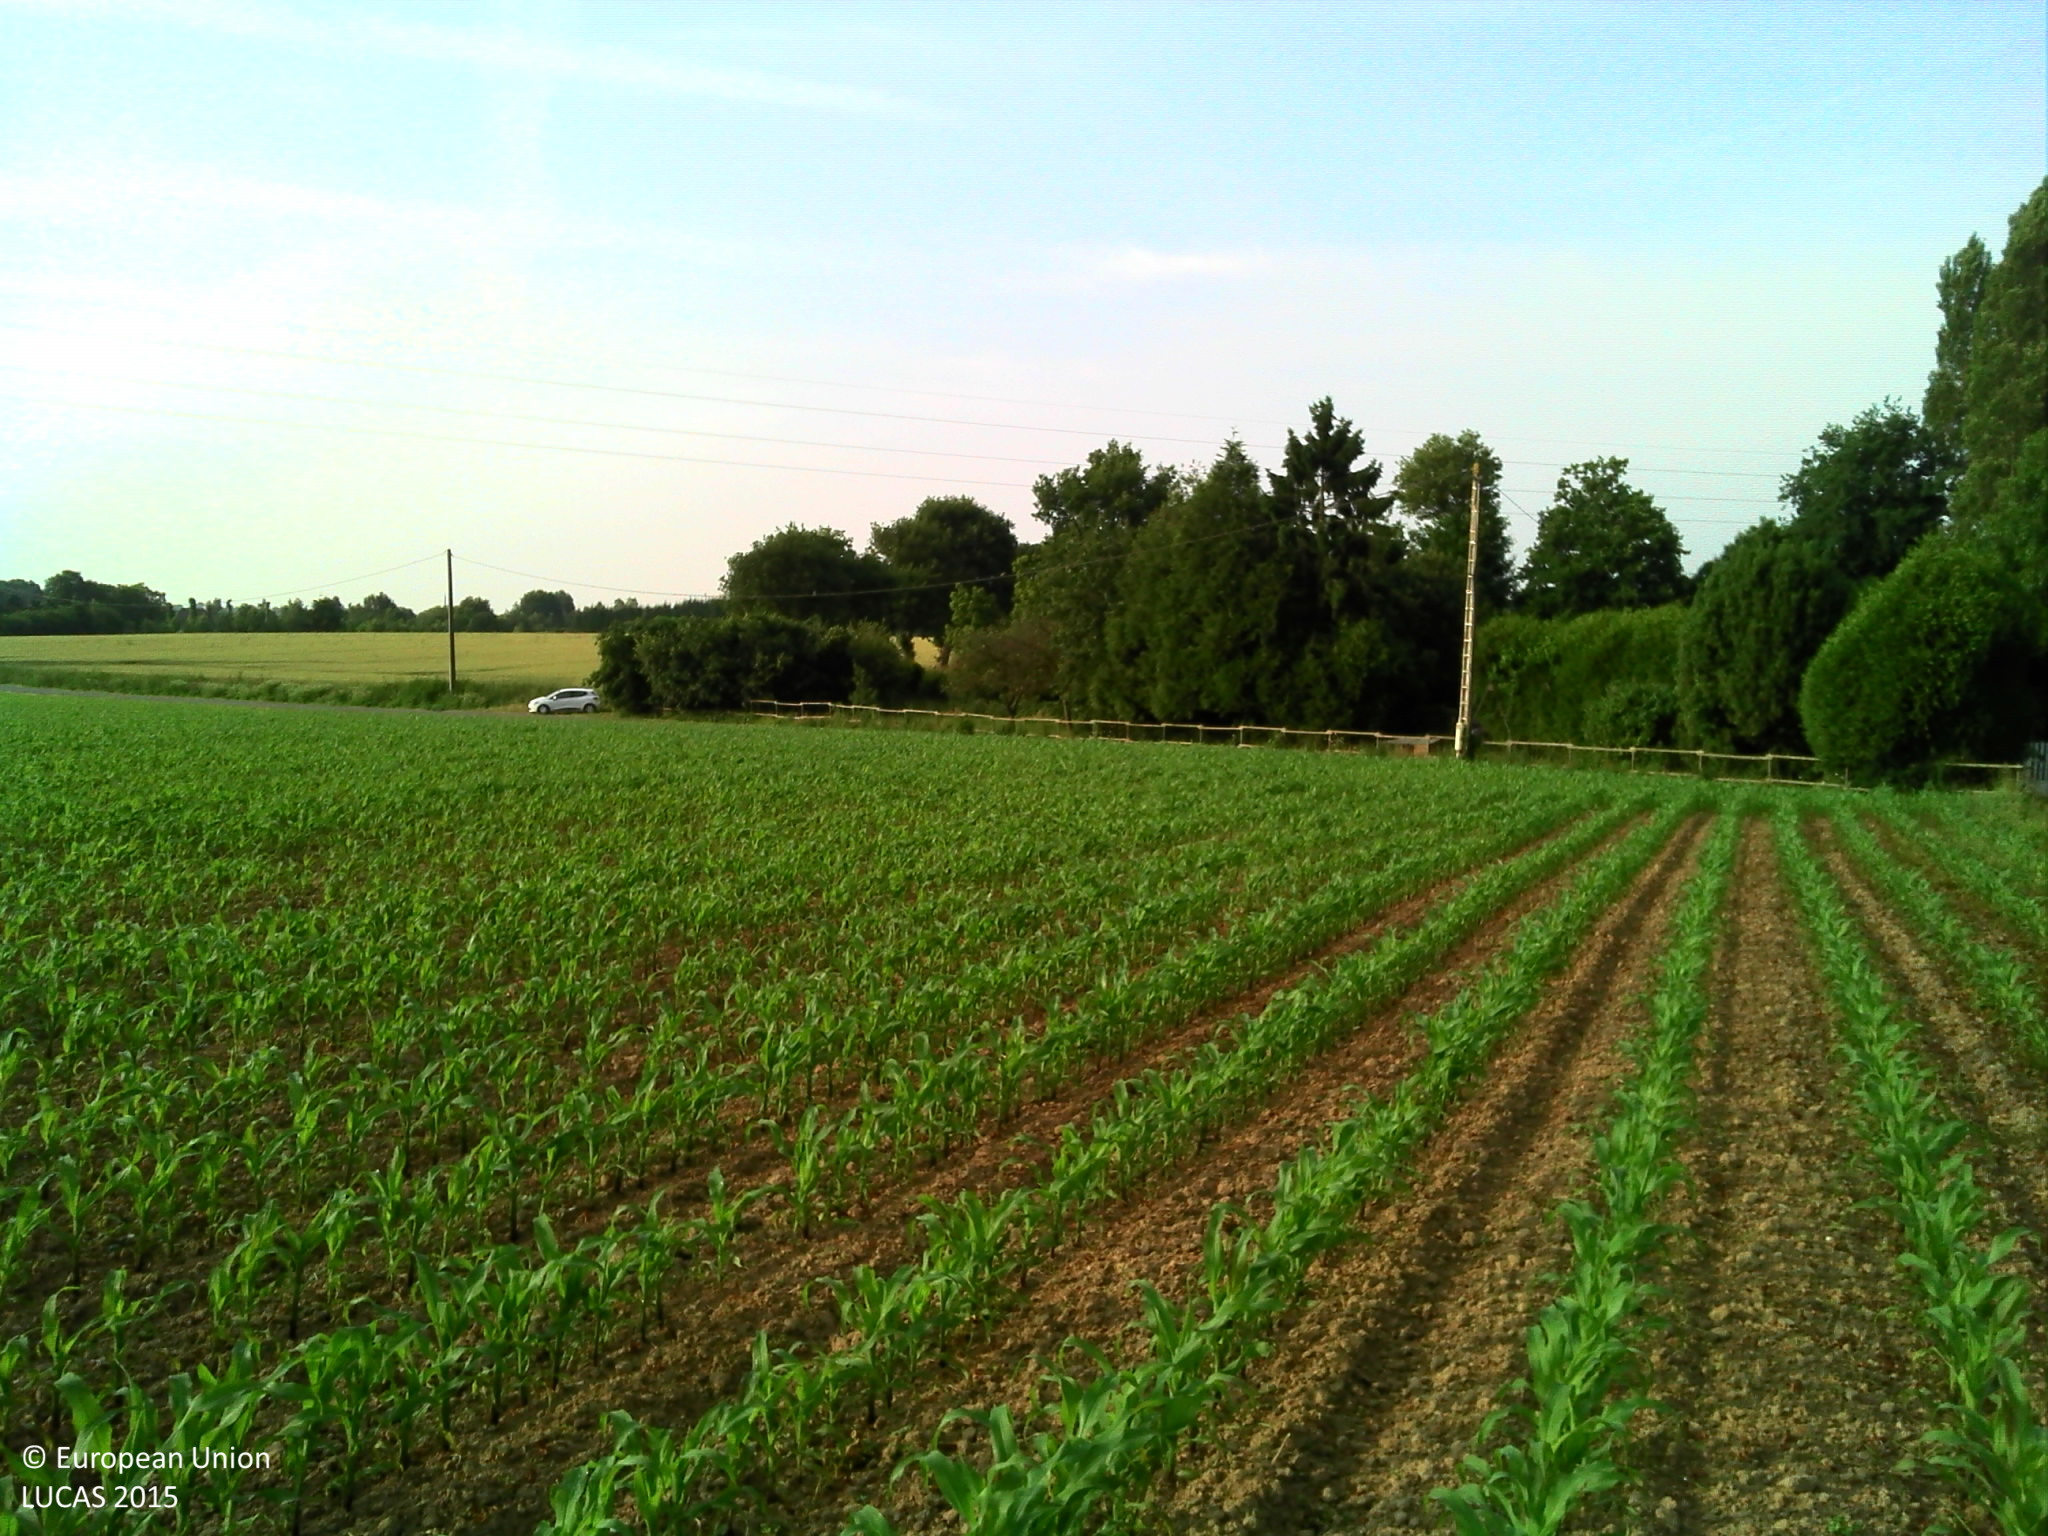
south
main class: Cropland
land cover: Maize
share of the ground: 25 - 50 %
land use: Agriculture (excluding fallow land and kitchen gardens)
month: June
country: FR
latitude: 48.1559
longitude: -1.9218
